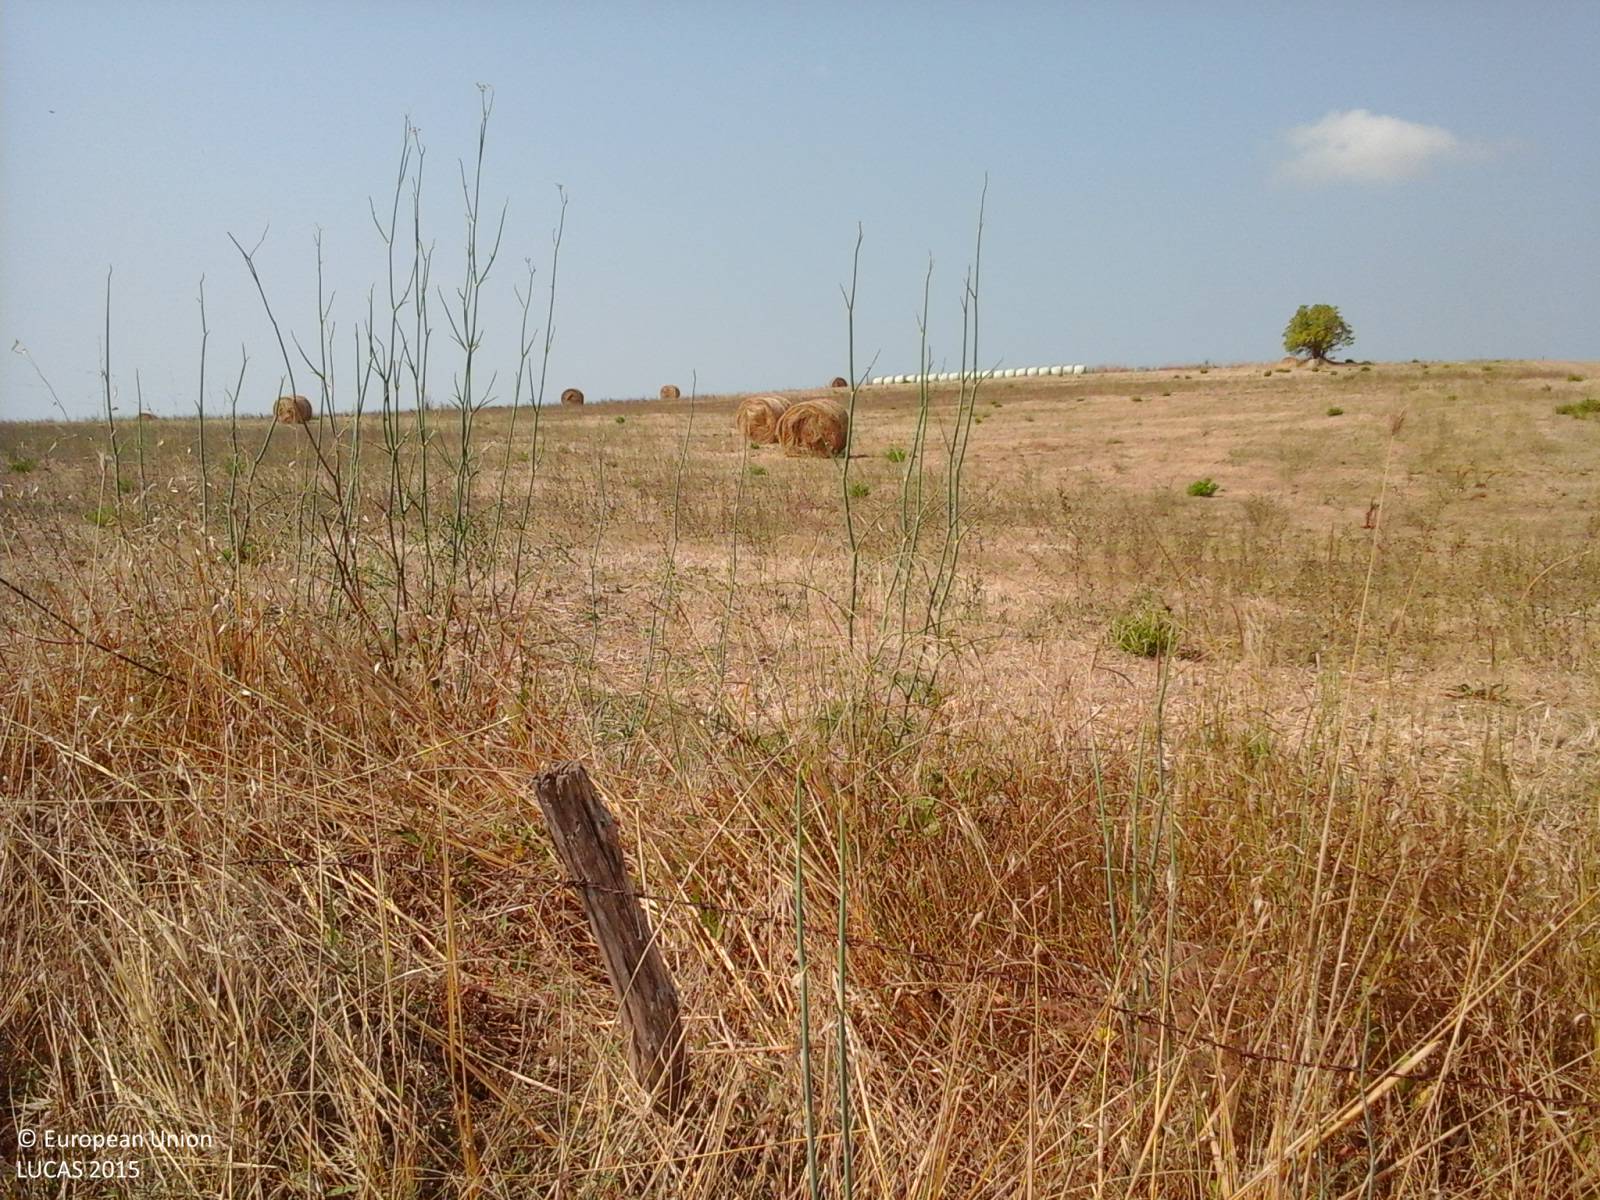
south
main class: Cropland
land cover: Mixed cereals for fodder
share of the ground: > 75 %
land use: Agriculture (excluding fallow land and kitchen gardens)
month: July
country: IT
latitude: 41.9615
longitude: 12.1998
